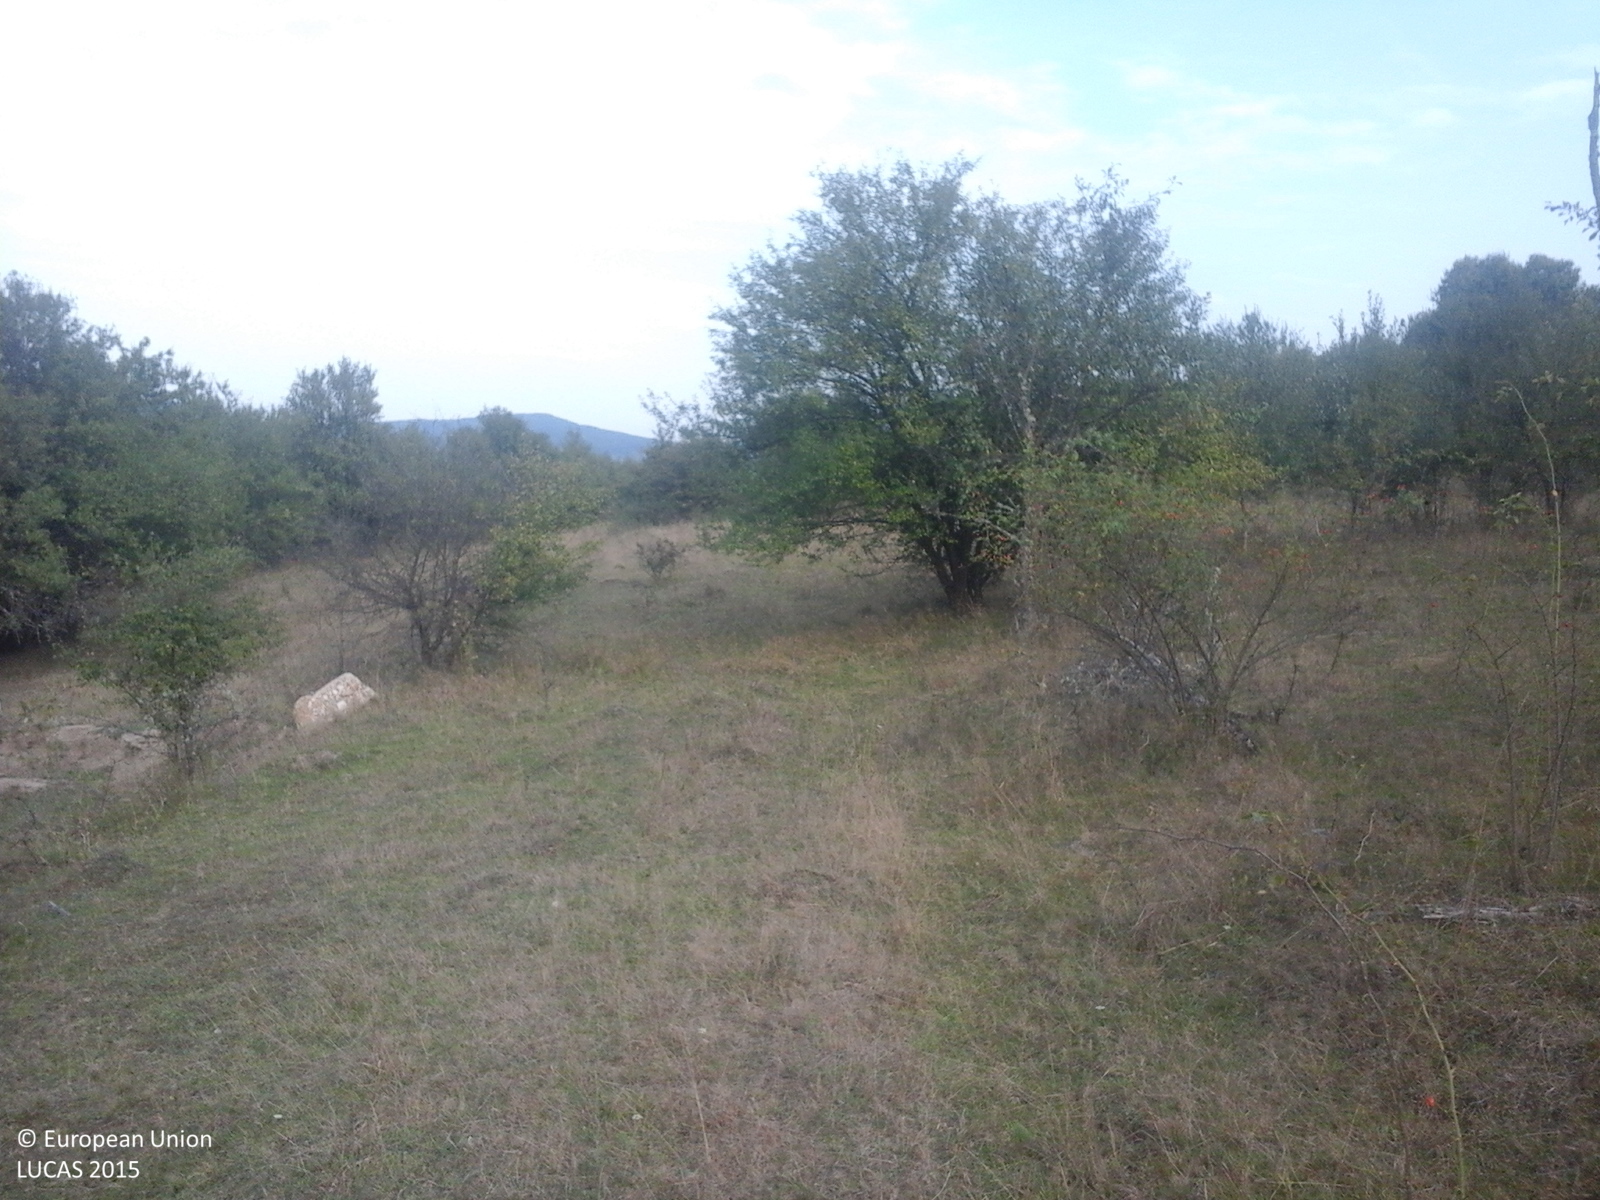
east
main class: Cropland
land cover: Other fruit trees and berries
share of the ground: > 75 %
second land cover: Grassland without tree/shrub cover
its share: > 75 %
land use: Agriculture (excluding fallow land and kitchen gardens)
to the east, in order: Other fruit trees and berries; Grassland without tree/shrub cover; Ditches and canals; Grass margins; Other fruit trees and berries
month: September
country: RO
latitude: 47.0200
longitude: 23.2355
